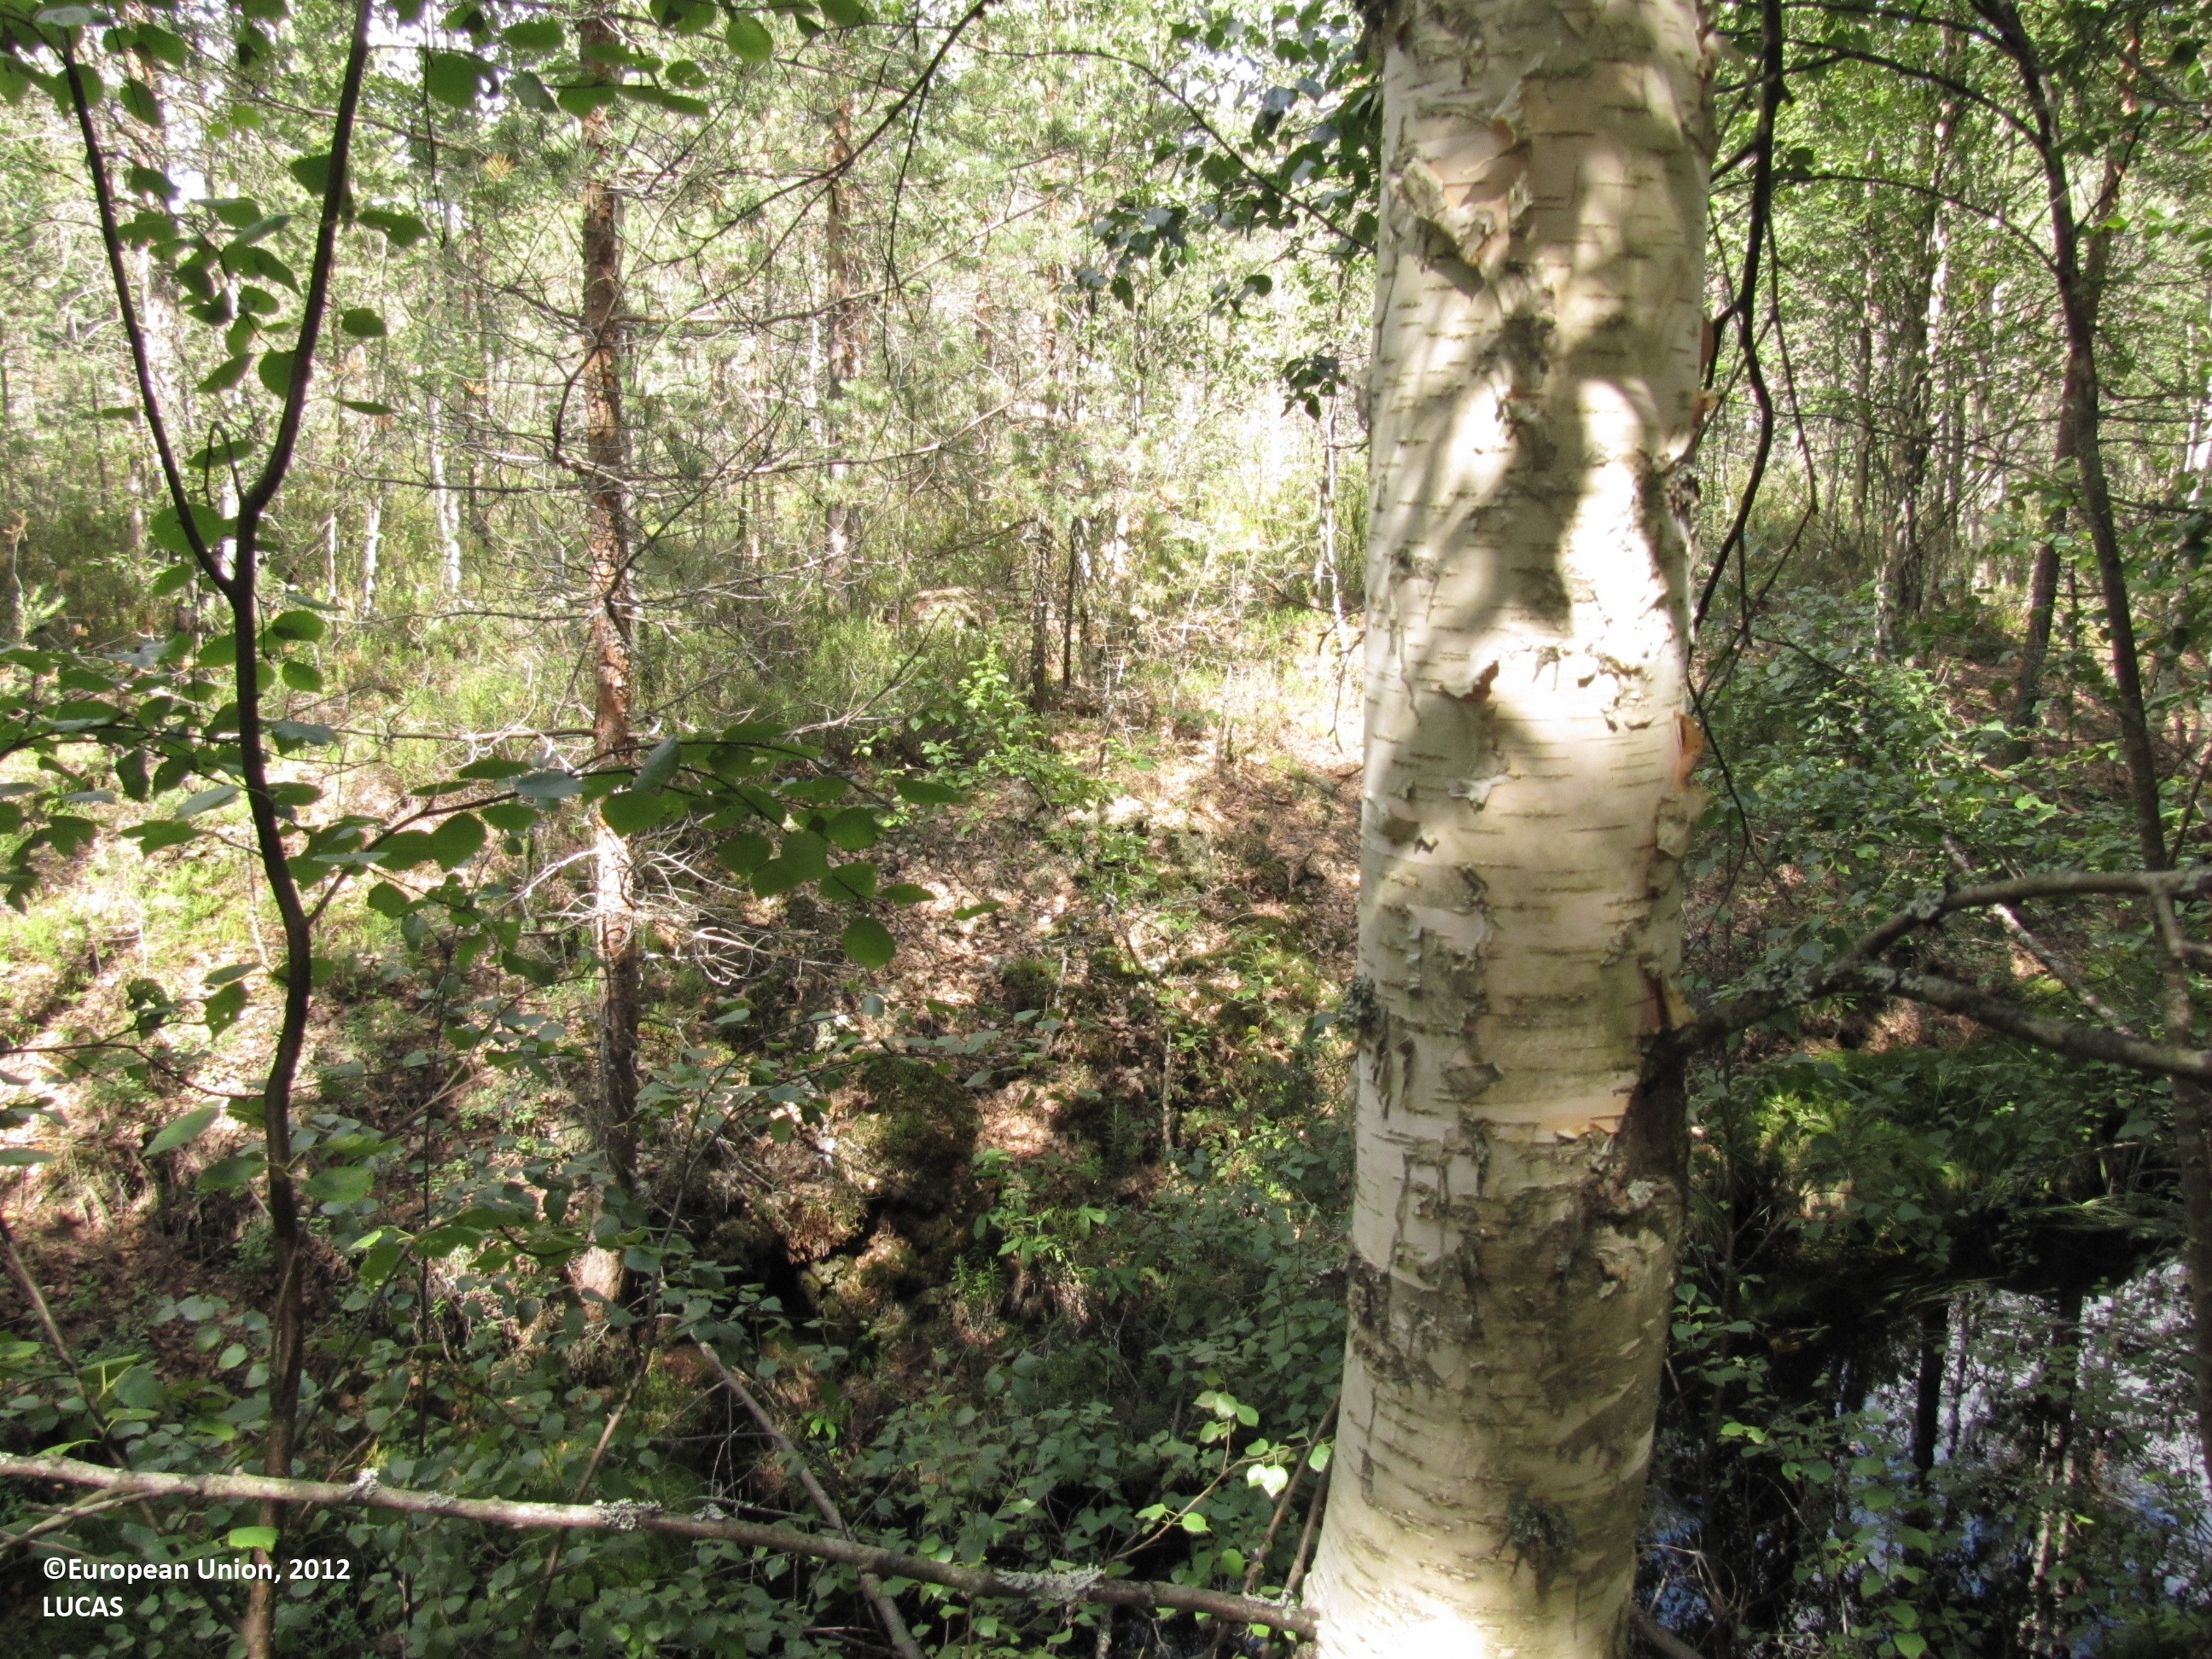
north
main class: Woodland
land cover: Pine dominated coniferous woodland
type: mire and swamp forests
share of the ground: > 75 %
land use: Forestry
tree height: > 5 m
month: July
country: FI
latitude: 62.5288
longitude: 23.3397
